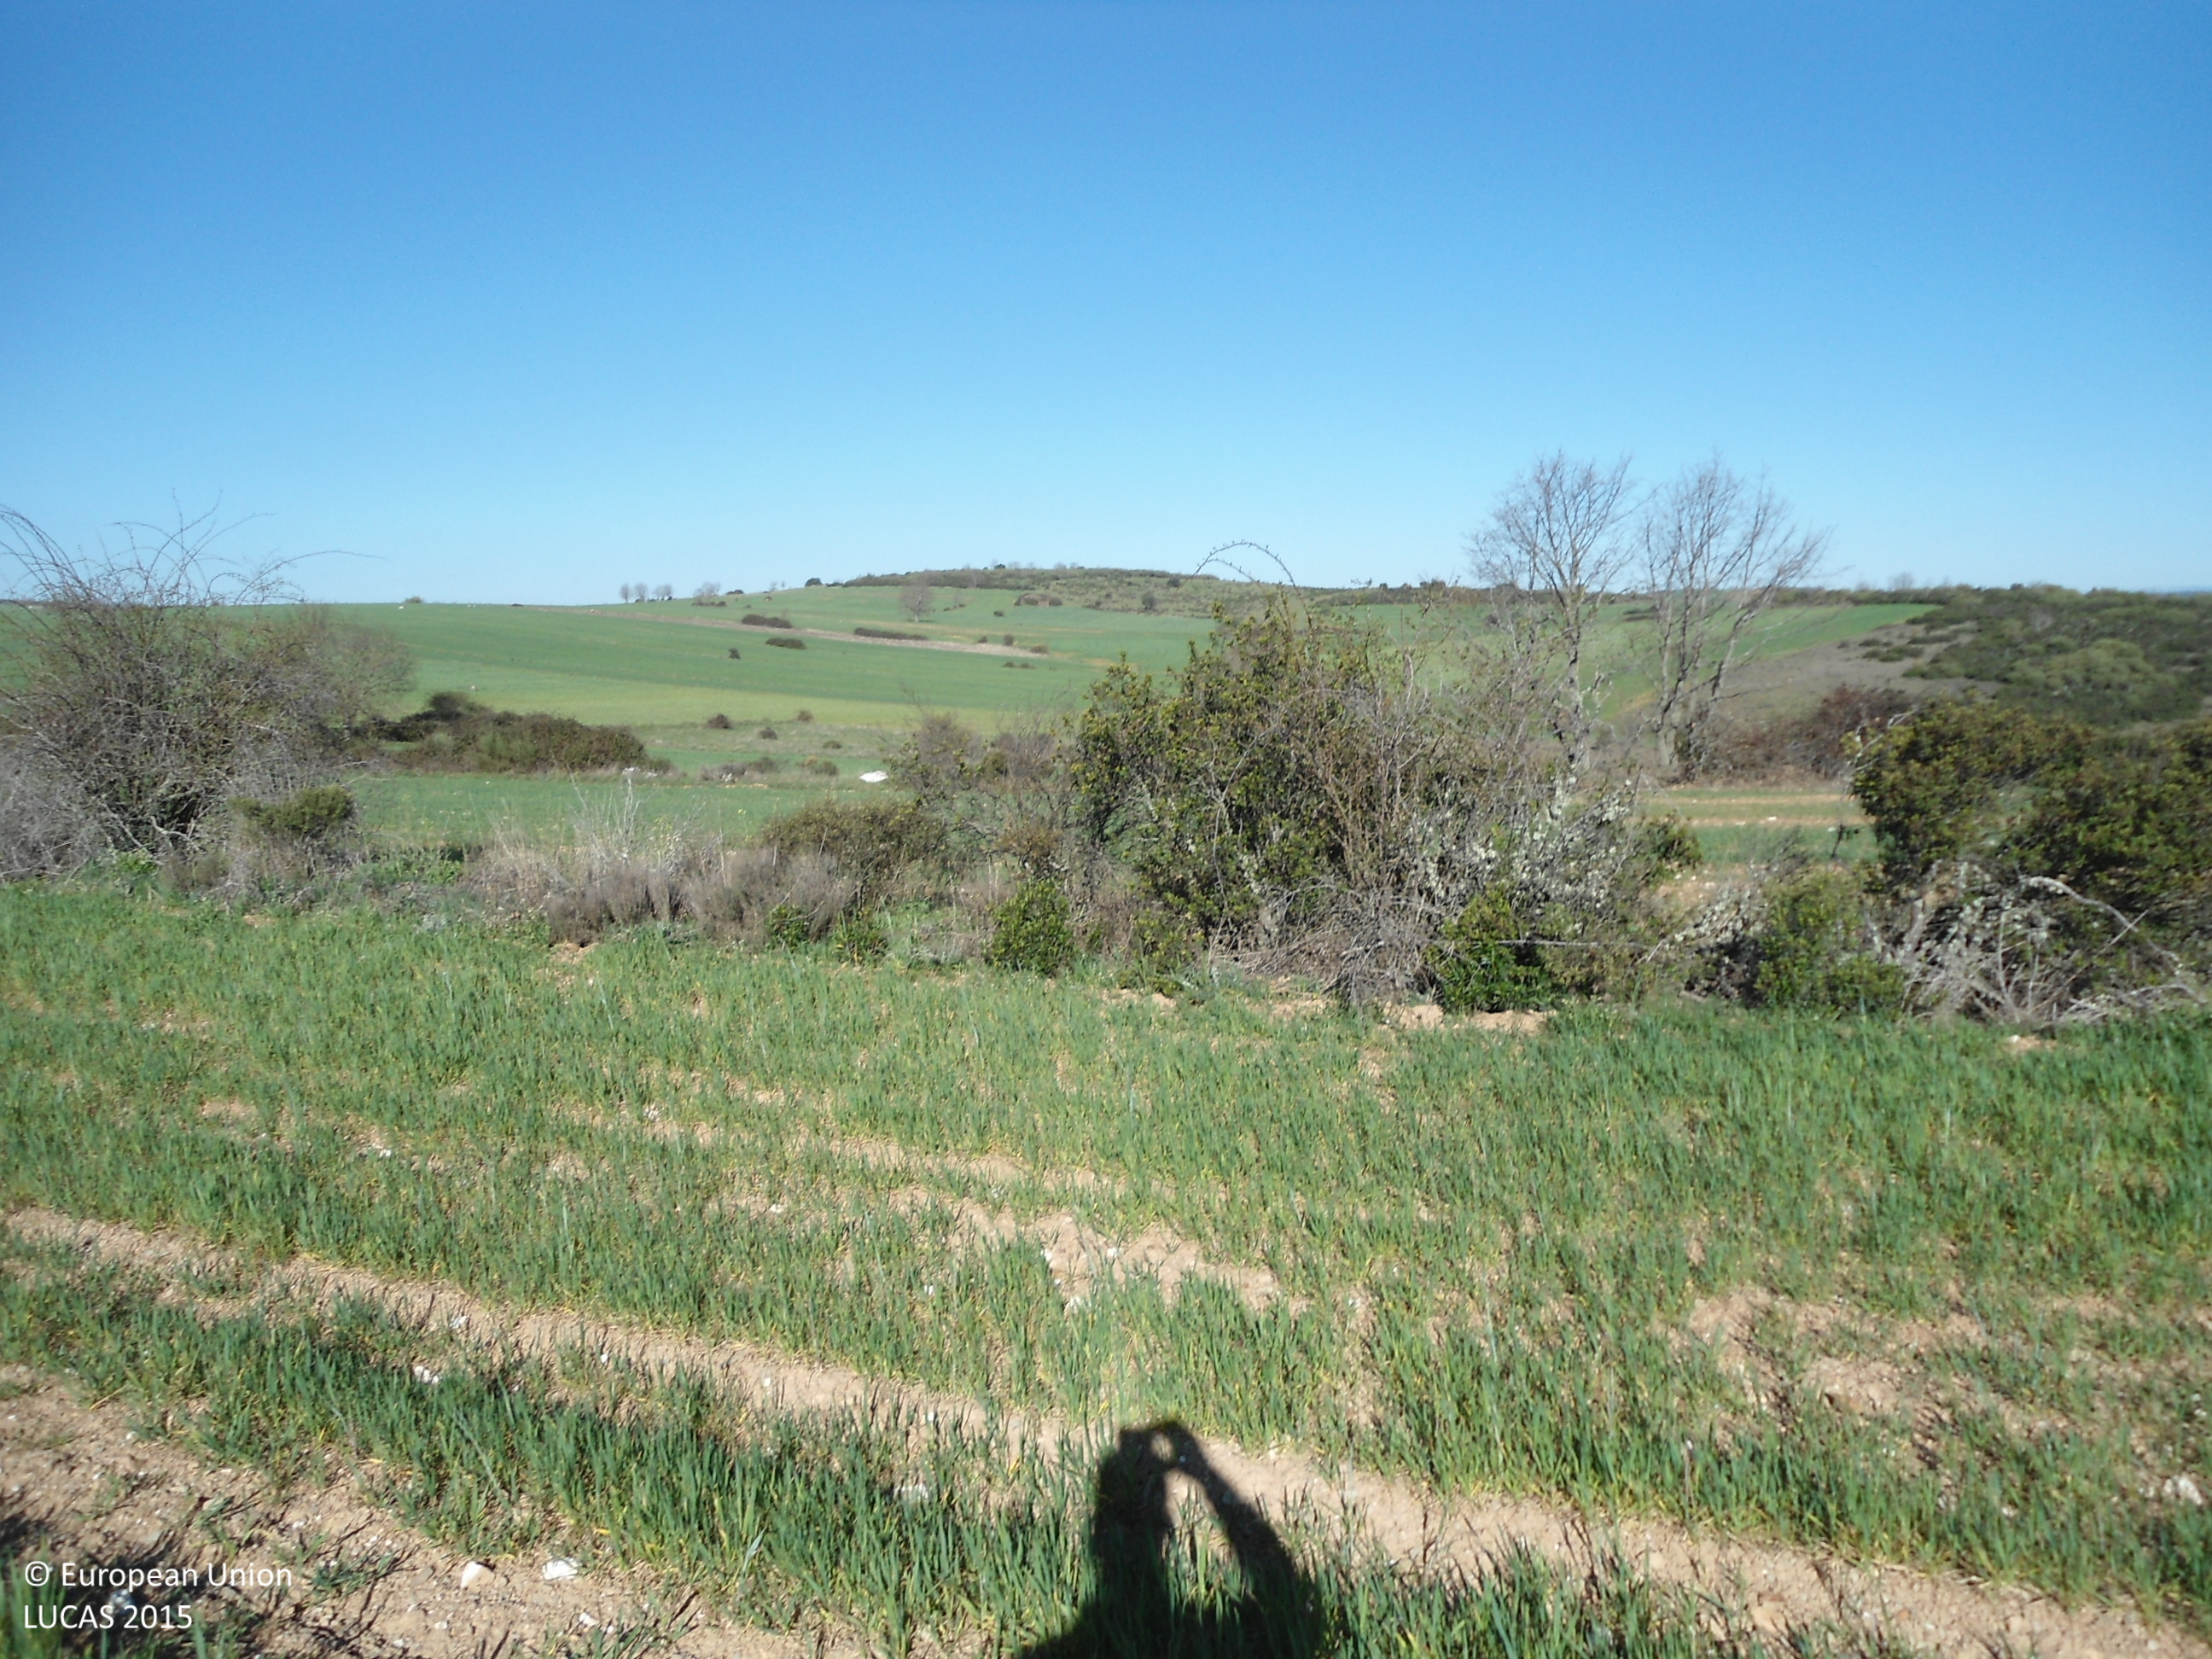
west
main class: Cropland
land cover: Common wheat
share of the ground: > 75 %
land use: Agriculture (excluding fallow land and kitchen gardens)
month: April
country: ES
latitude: 41.6638
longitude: -6.1298
